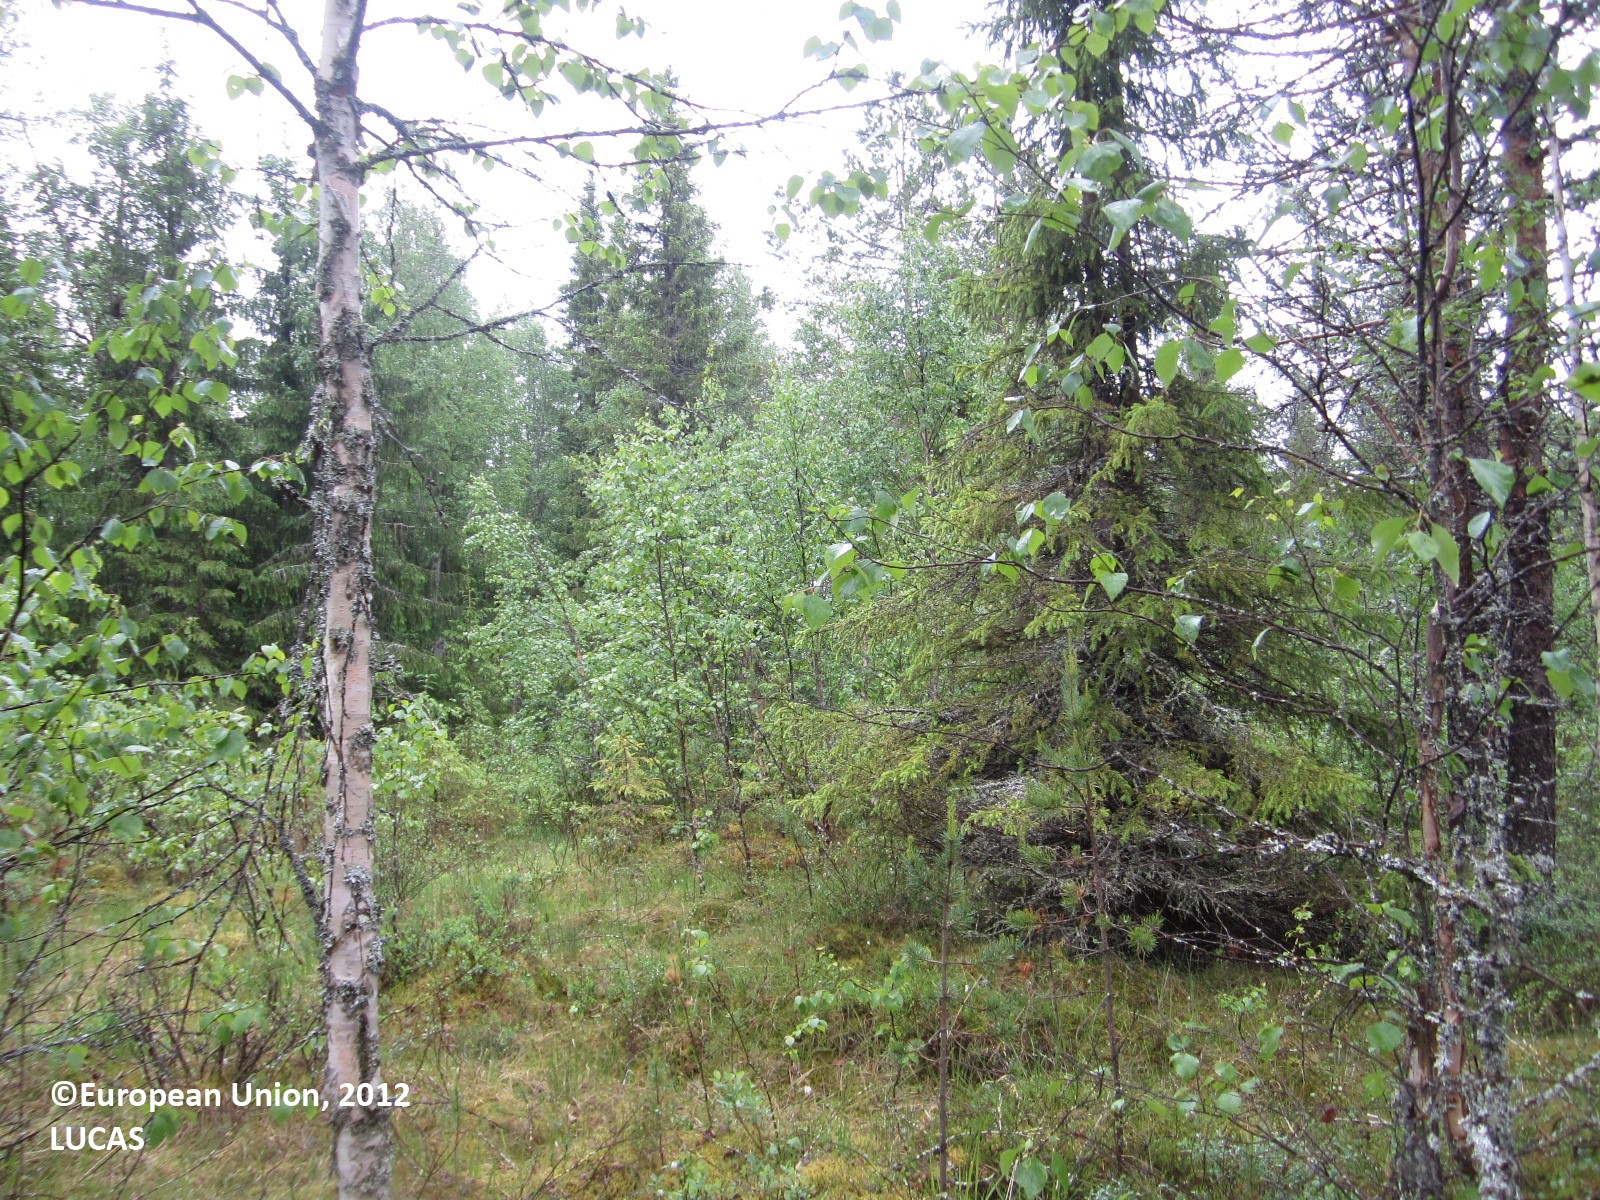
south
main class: Woodland
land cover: Pine dominated mixed woodland
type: boreal forest
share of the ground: 50 - 75 %
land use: Forestry
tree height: > 5 m
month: June
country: FI
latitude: 64.6151
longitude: 29.7701
